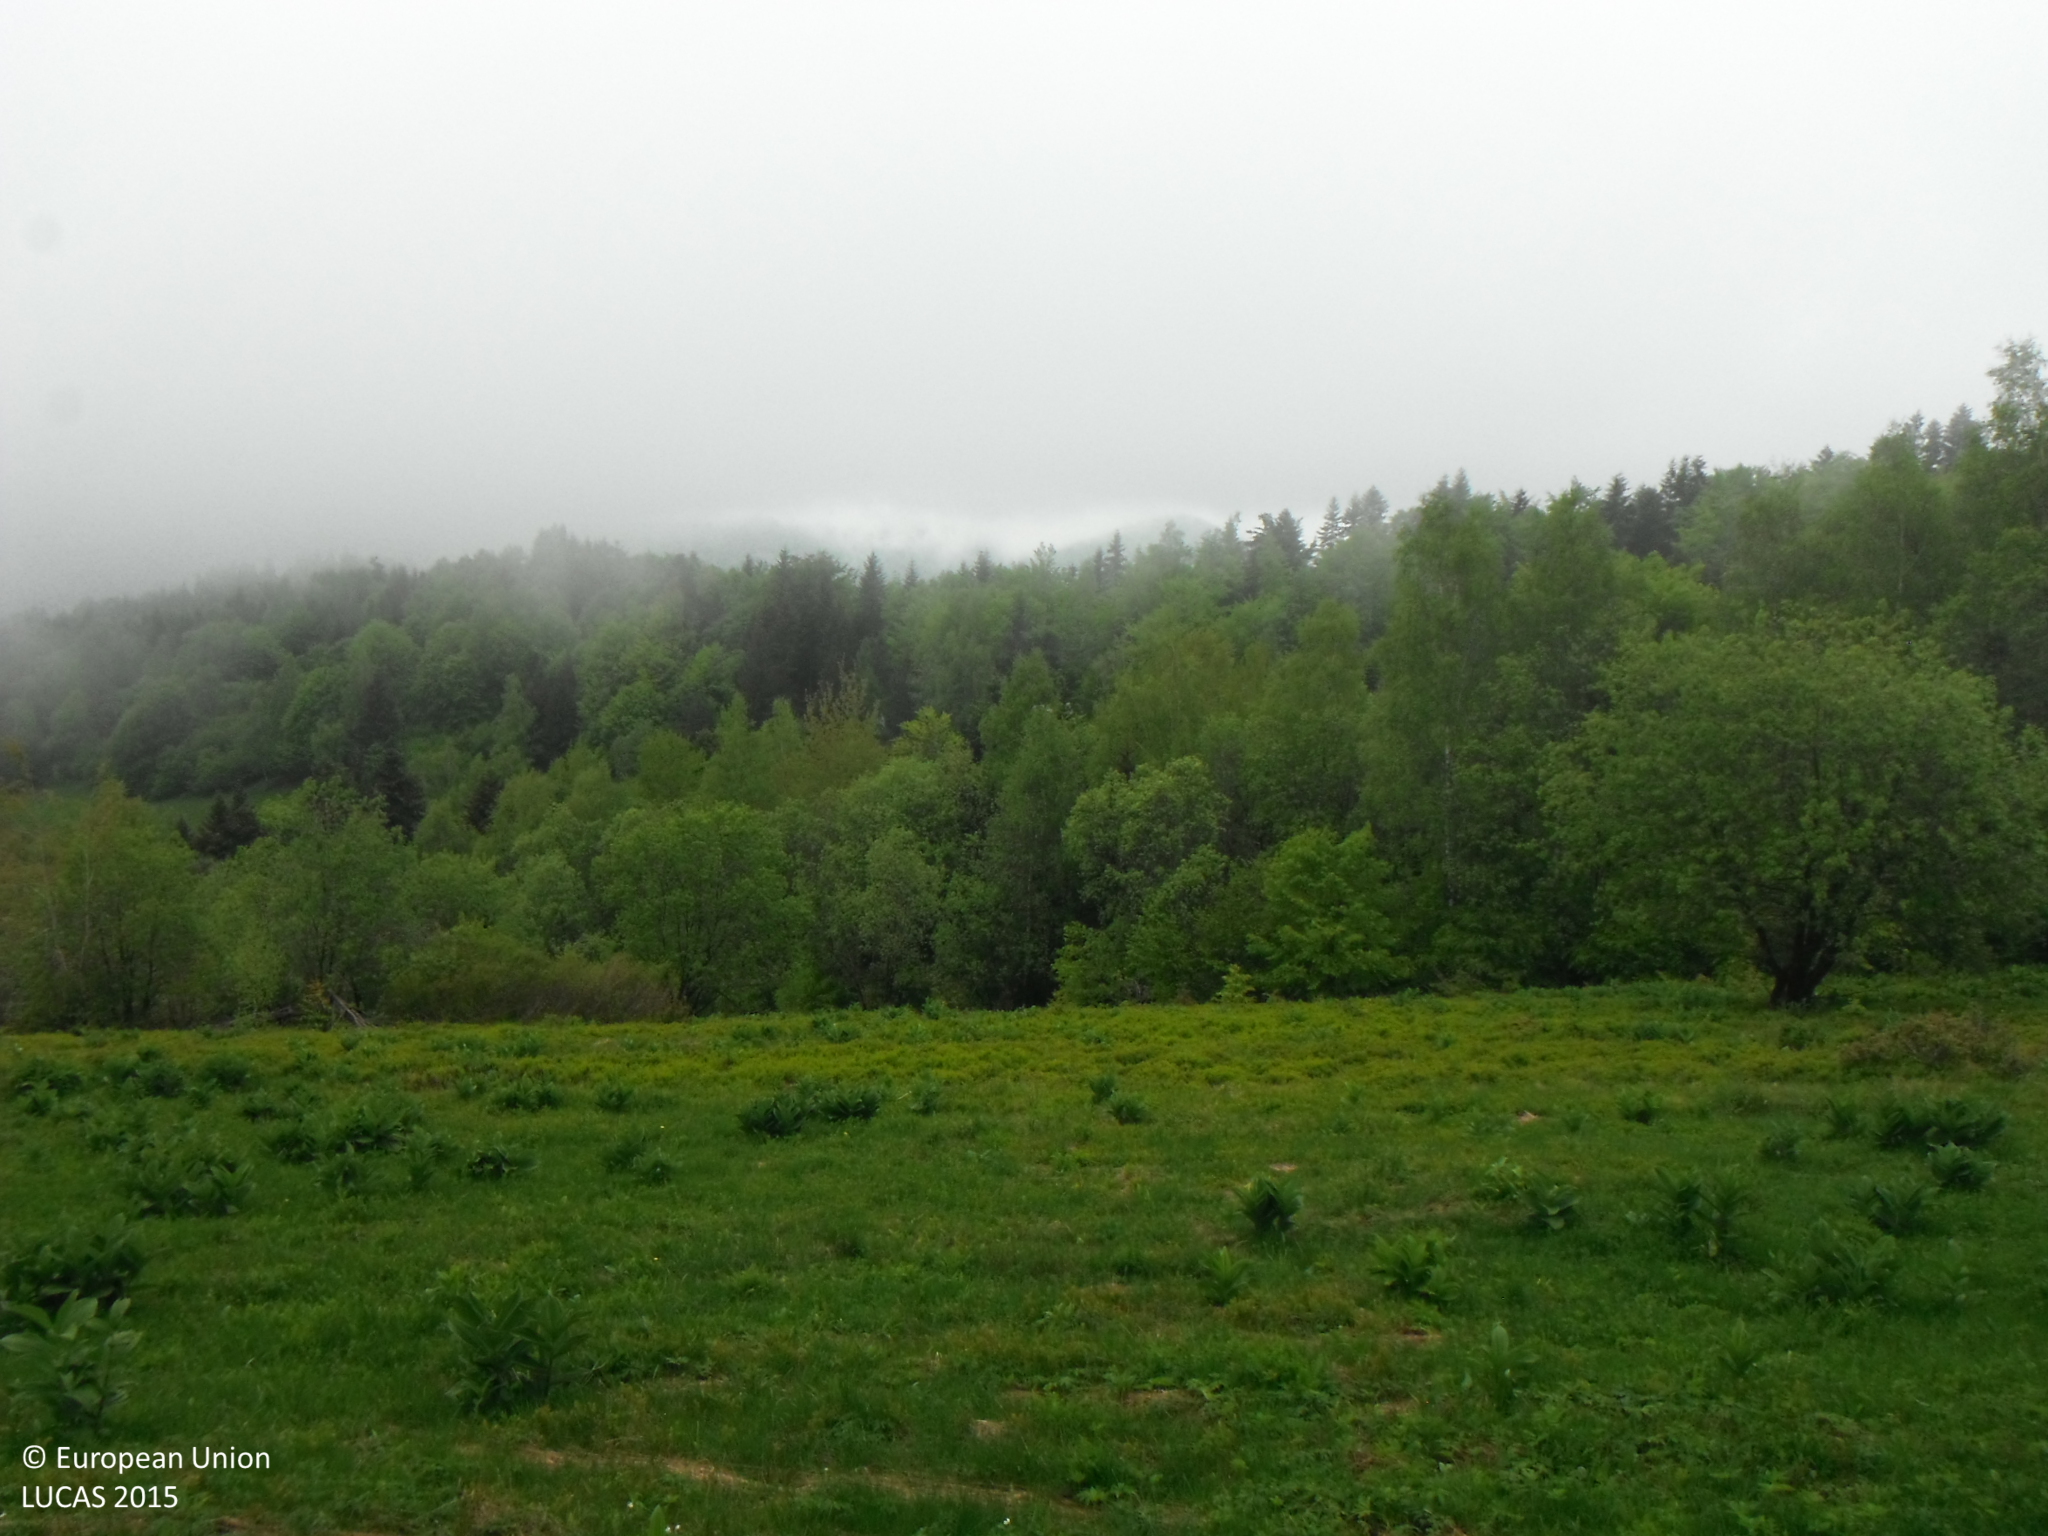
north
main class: Grassland
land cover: Spontaneously vegetated surfaces
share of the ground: > 75 %
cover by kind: herbaceous plants 100 %
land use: Sport
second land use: Amenities, museums, leisure
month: May
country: SK
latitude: 49.1645
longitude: 21.1388
